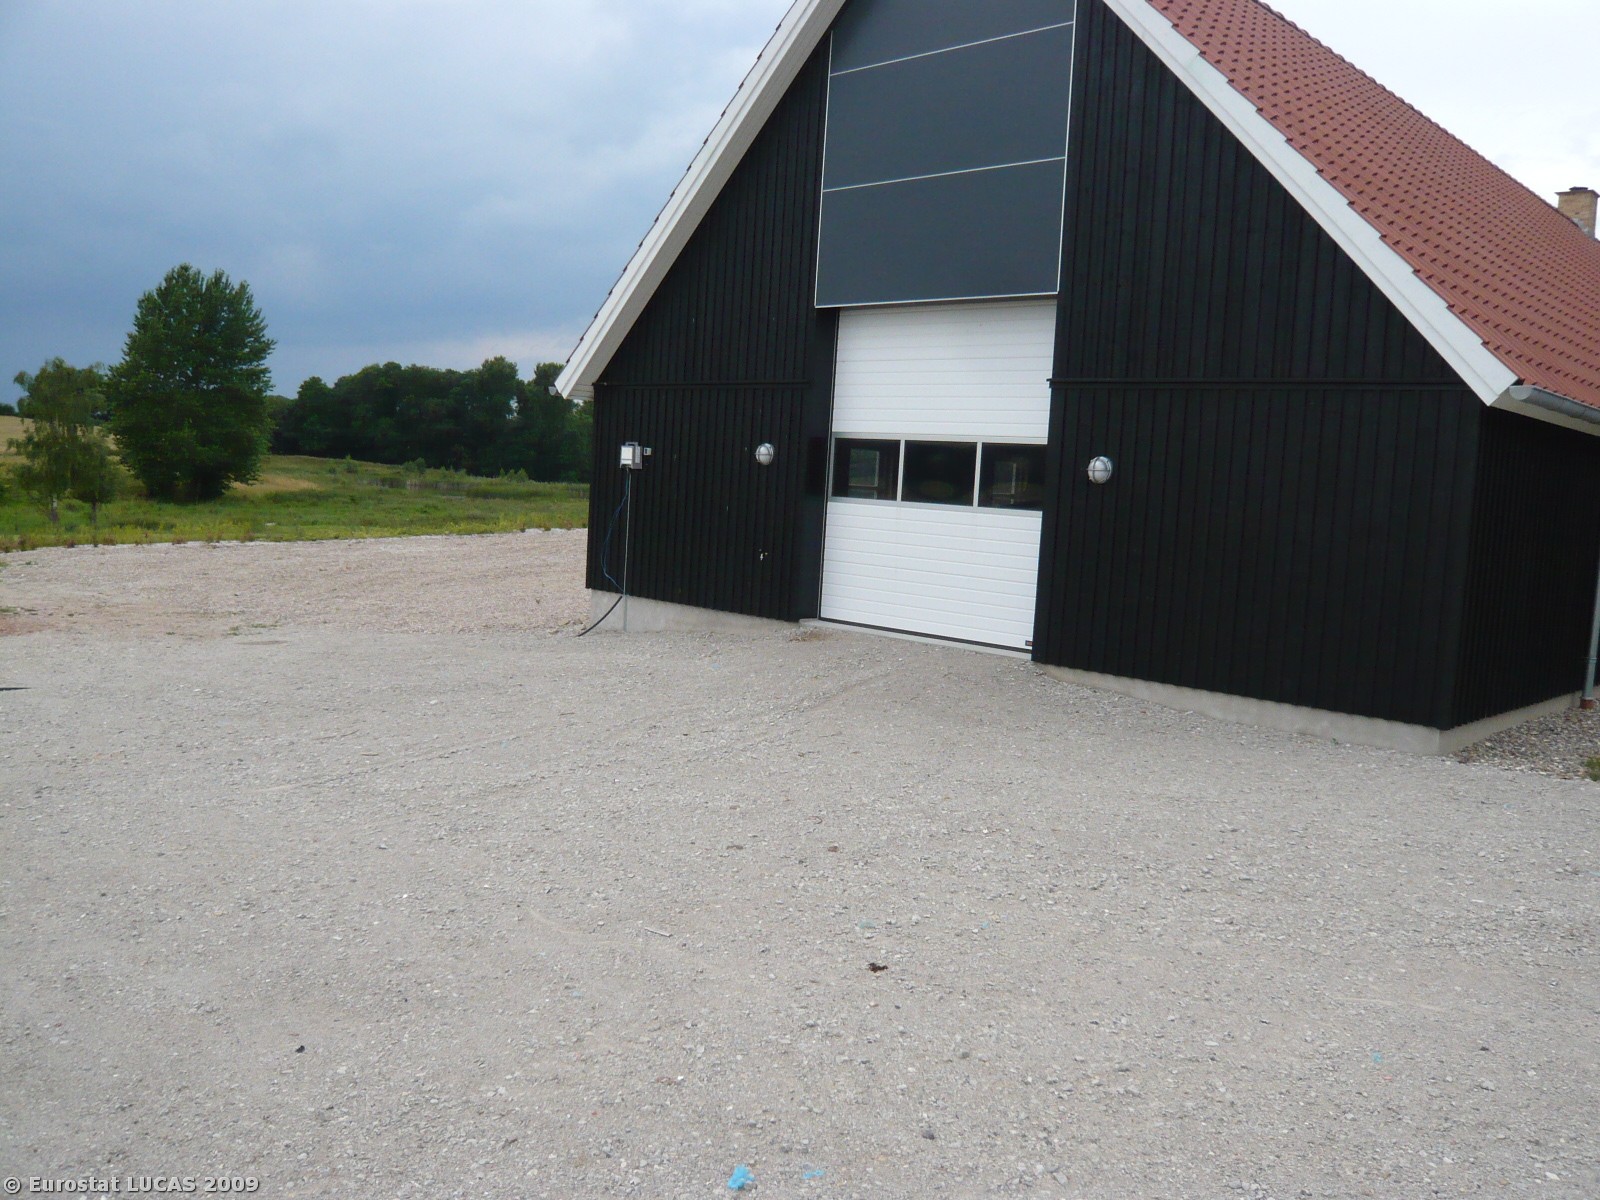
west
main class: Cropland
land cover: Rape and turnip rape
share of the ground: > 75 %
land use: Agriculture (excluding fallow land and kitchen gardens)
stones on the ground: < 10 %
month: July
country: DK
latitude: 55.7308
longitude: 11.3841
